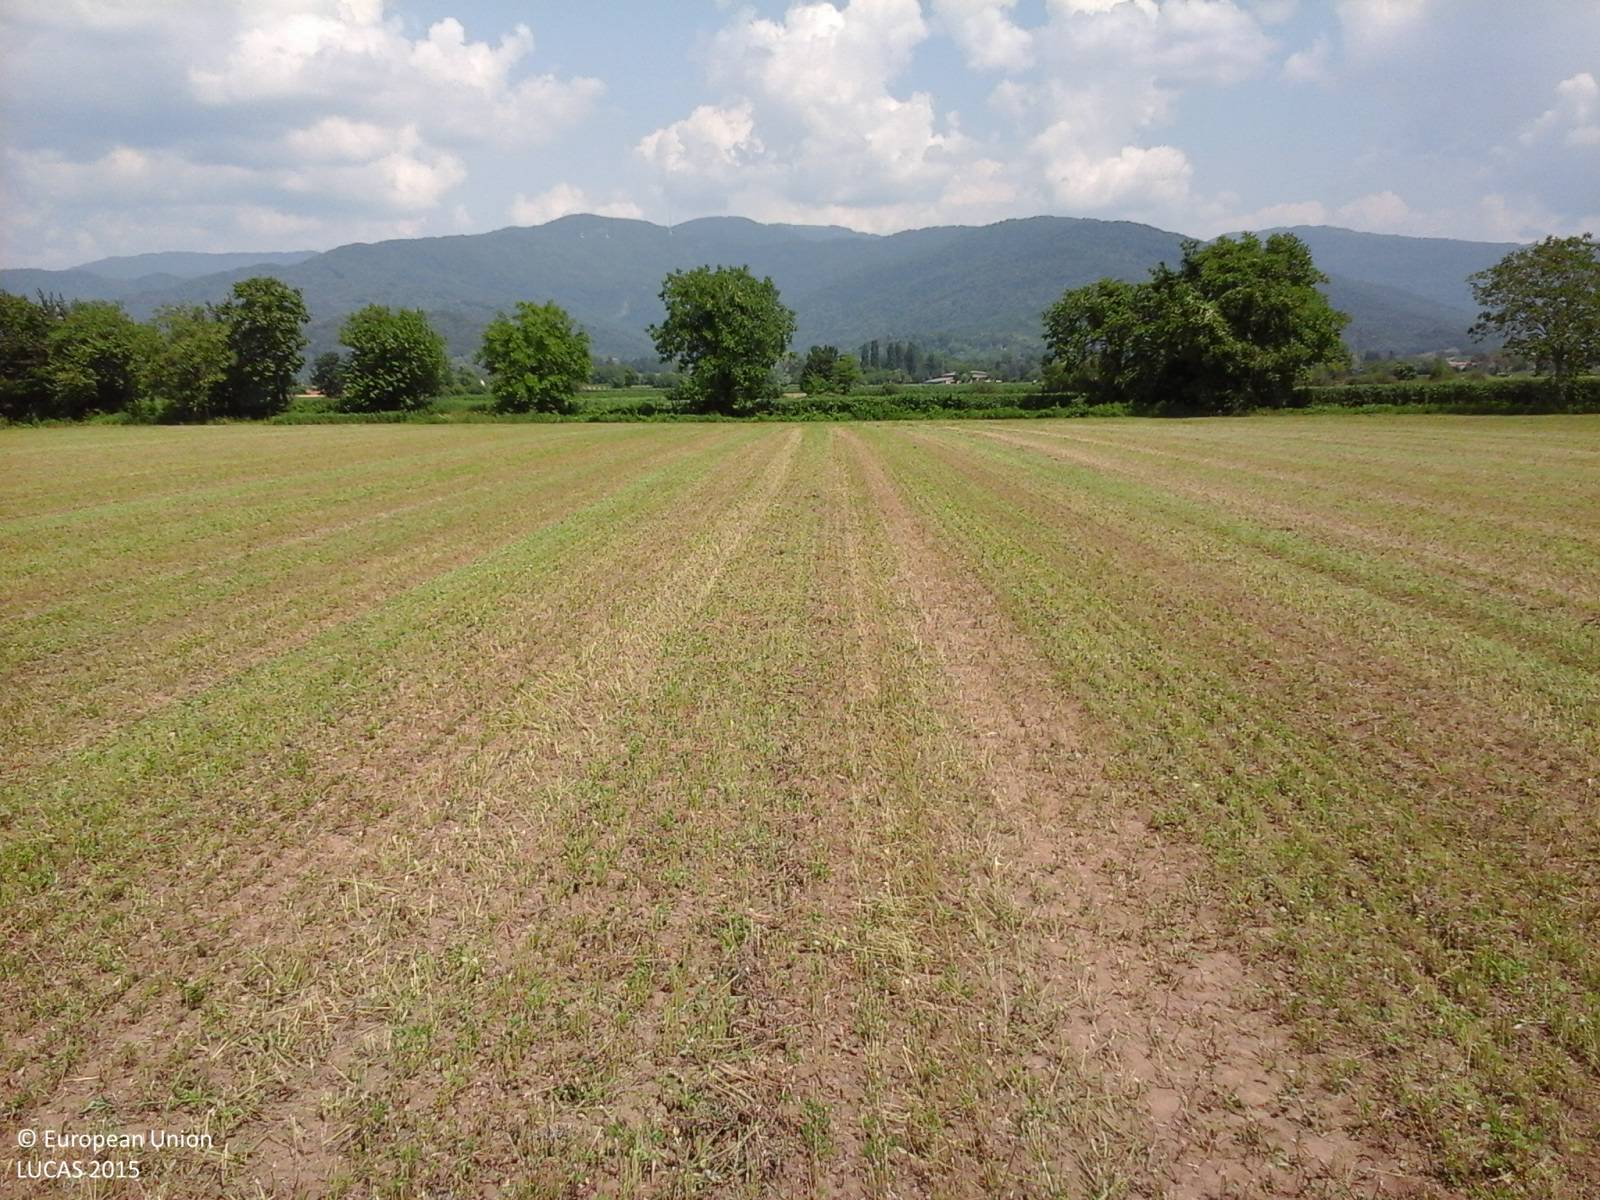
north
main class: Cropland
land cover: Other leguminous and mixtures for fodder
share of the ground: > 75 %
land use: Agriculture (excluding fallow land and kitchen gardens)
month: June
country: IT
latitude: 46.0989
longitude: 13.3985
